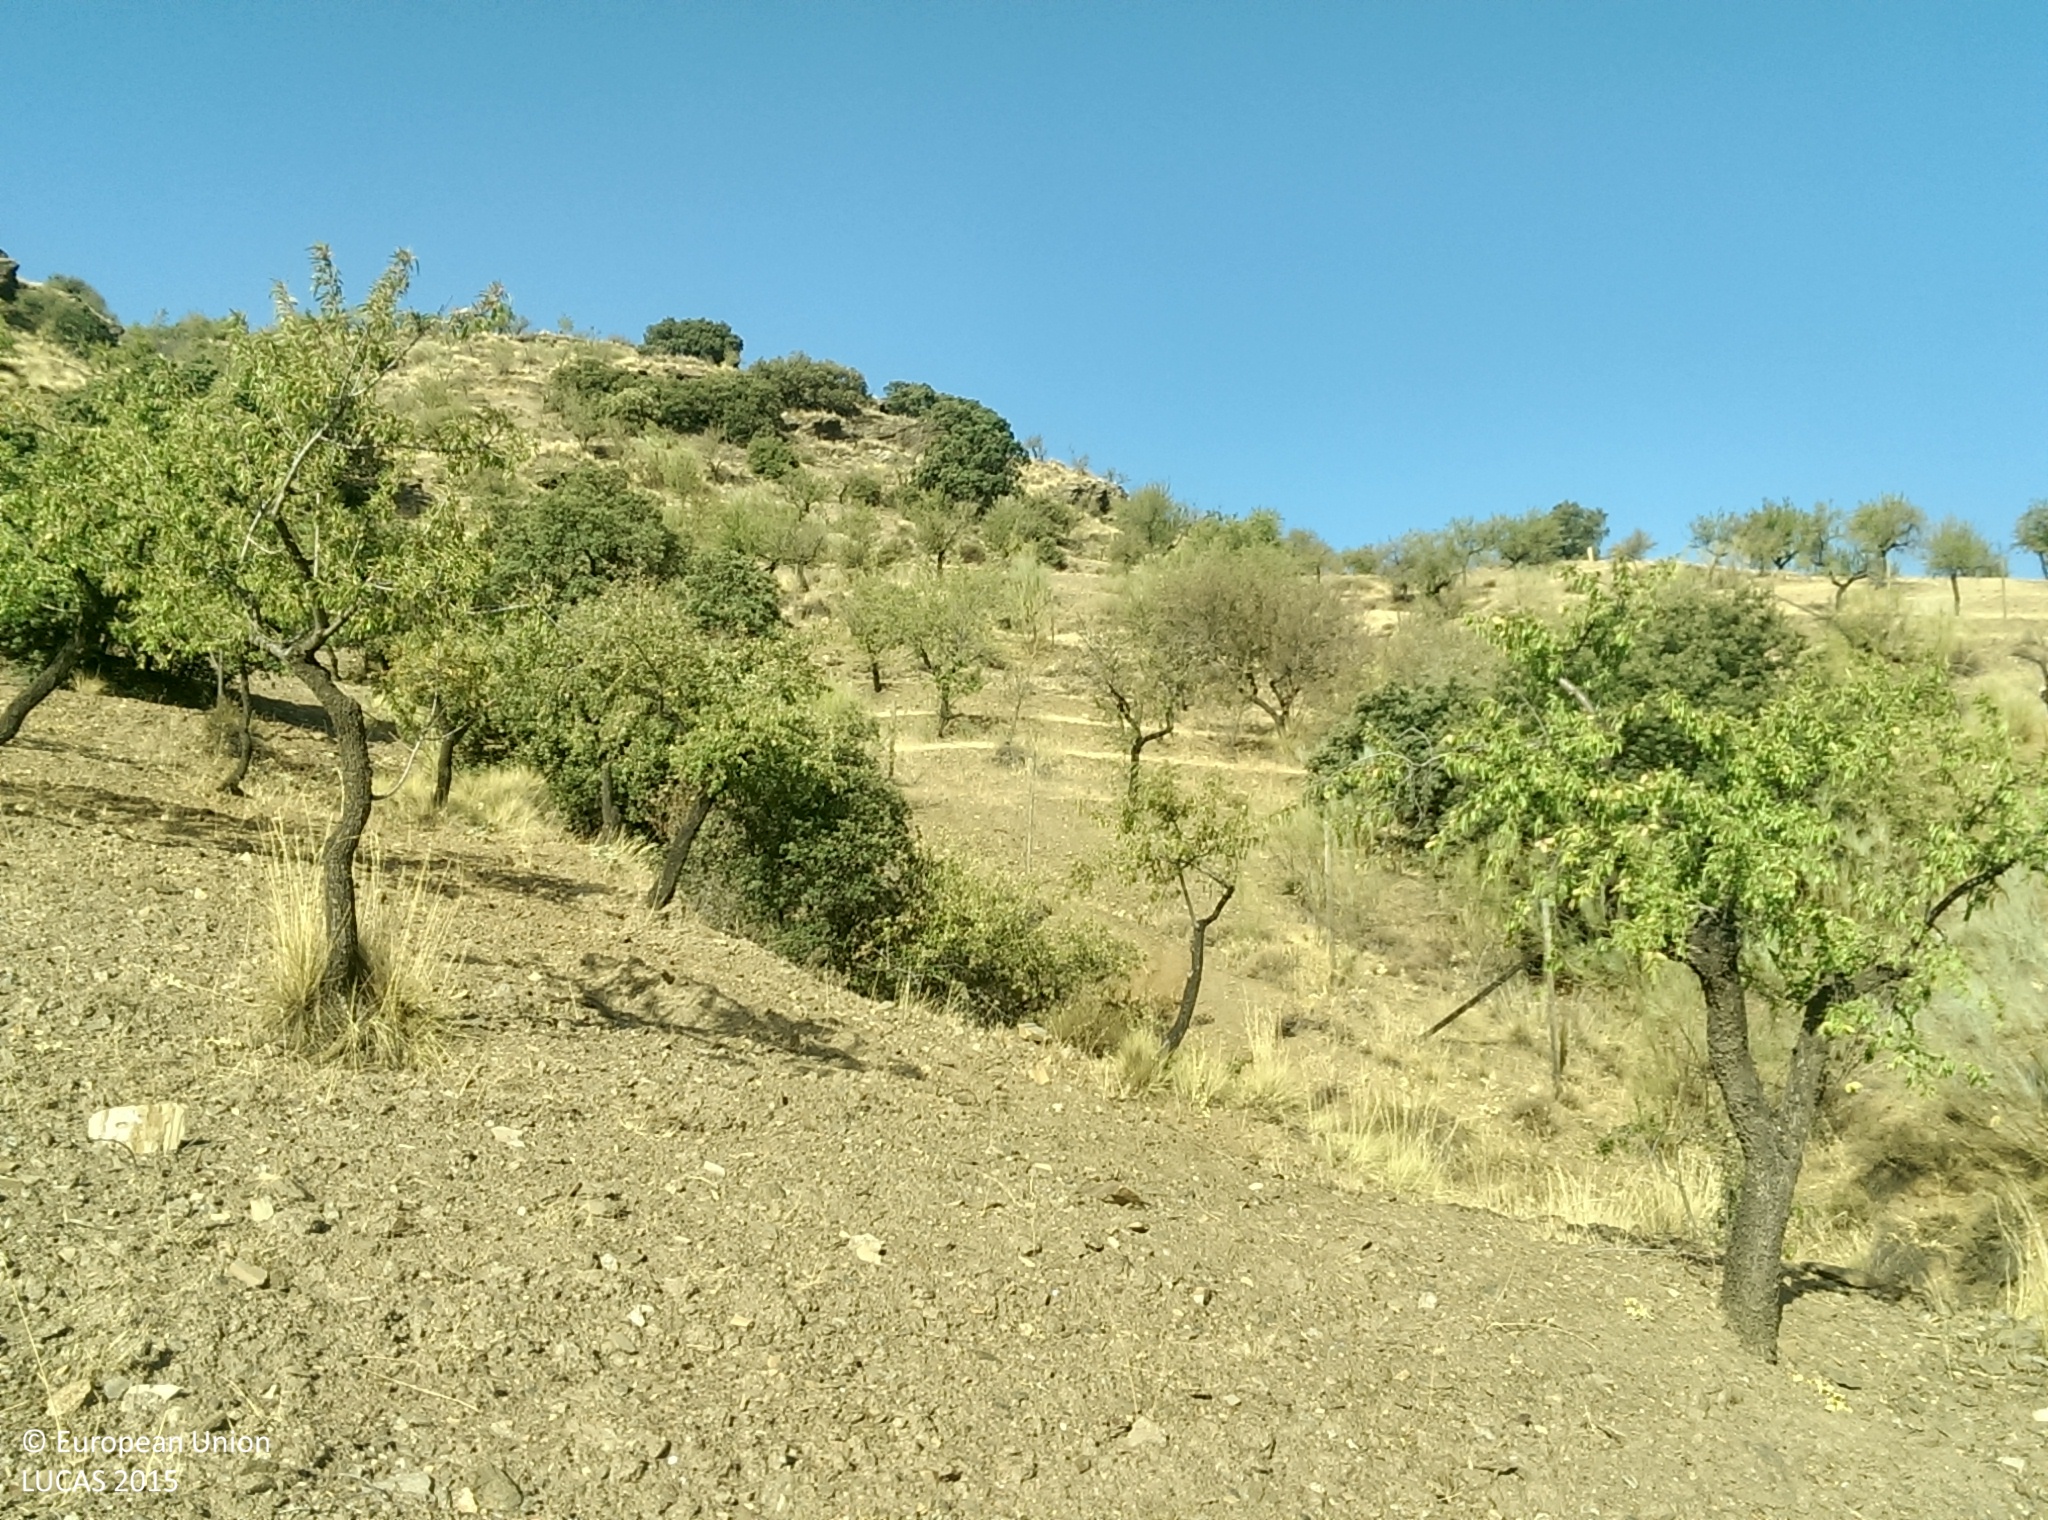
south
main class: Cropland
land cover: Nuts trees
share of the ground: < 10 %
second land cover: Other bare soil
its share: > 75 %
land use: Agriculture (excluding fallow land and kitchen gardens)
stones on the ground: 25 - 50 %
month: July
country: ES
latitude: 37.1319
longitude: -2.8257
